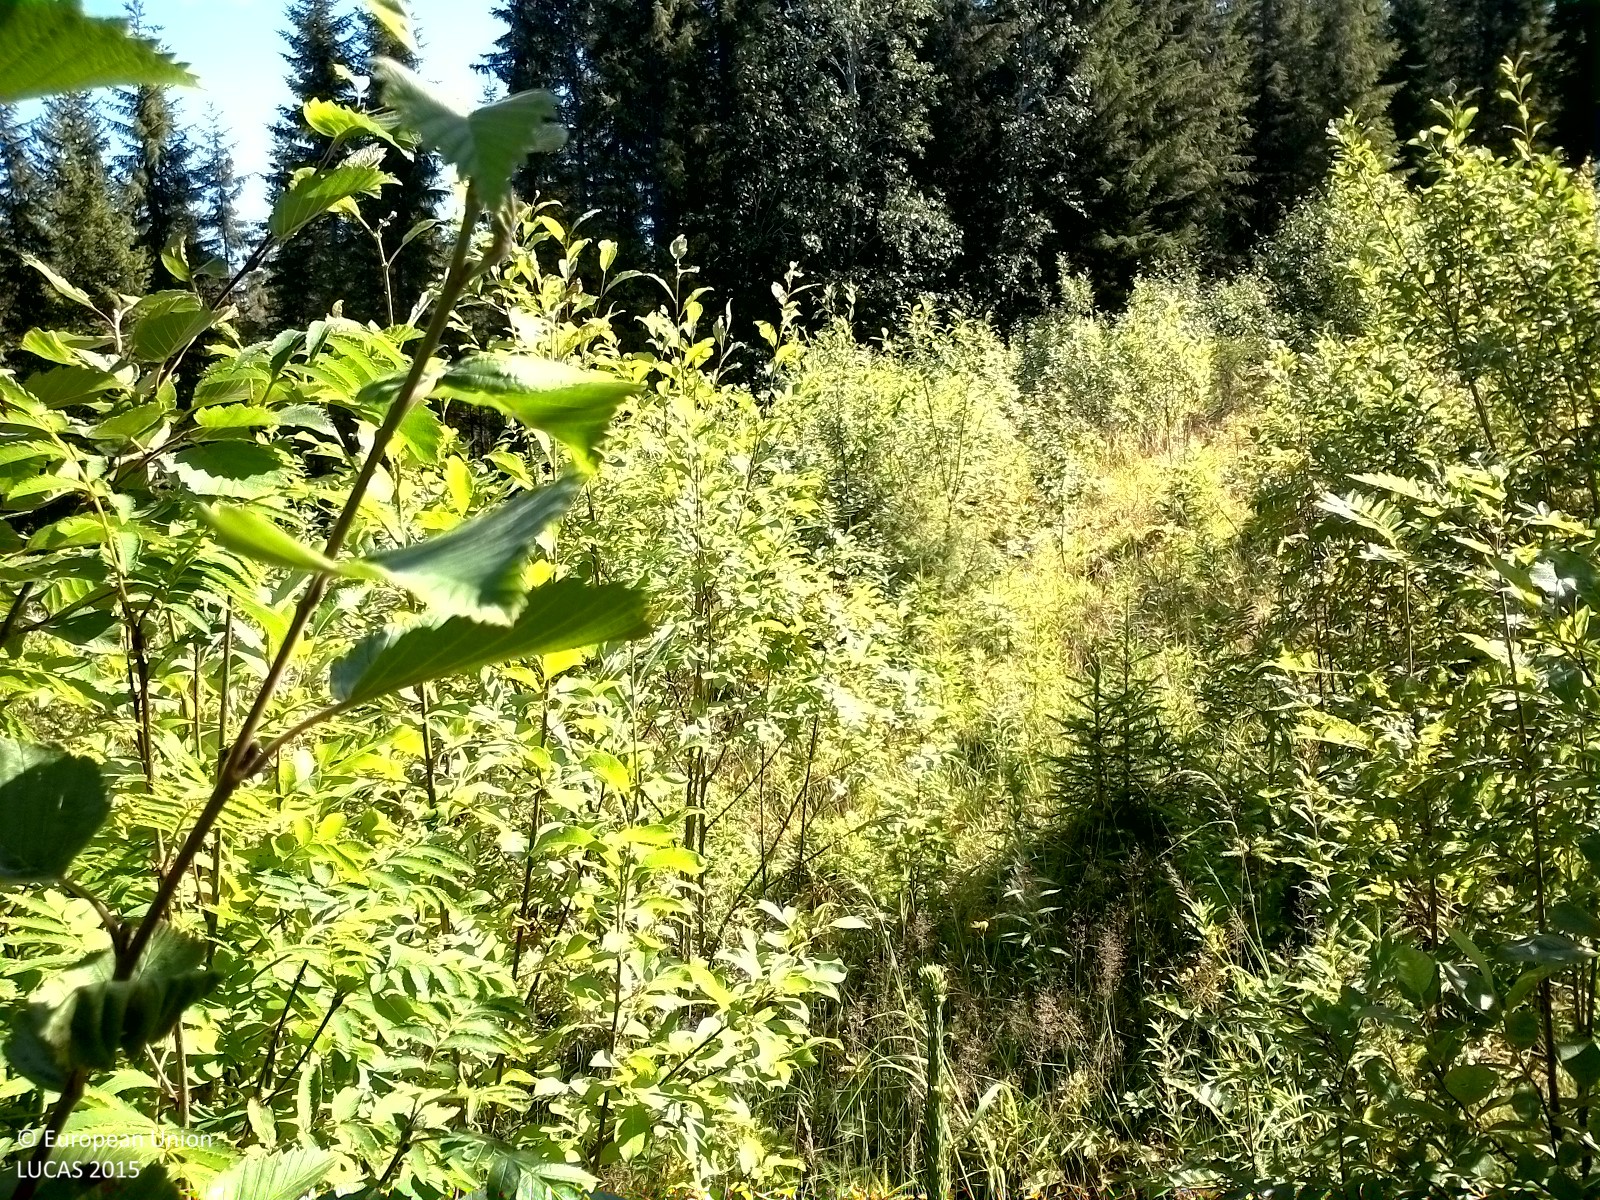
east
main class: Artificial land
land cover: Other artificial areas
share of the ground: > 75 %
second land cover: Broadleaved woodland
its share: > 75 %
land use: Electricity, gas and thermal power distribution
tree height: < 5 m
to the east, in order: Artificial constructions in urban areas; Broadleaved woodland; Spruce dominated coniferous woodland; Tracks; Spruce dominated coniferous woodland; Tracks; Spruce dominated coniferous woodland; Tracks; Spruce dominated coniferous woodland; Tracks; Spruce dominated coniferous woodland; Tracks; Spruce dominated coniferous woodland; Tracks; Spruce dominated coniferous woodland
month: August
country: SE
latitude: 62.3295
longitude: 16.4464
